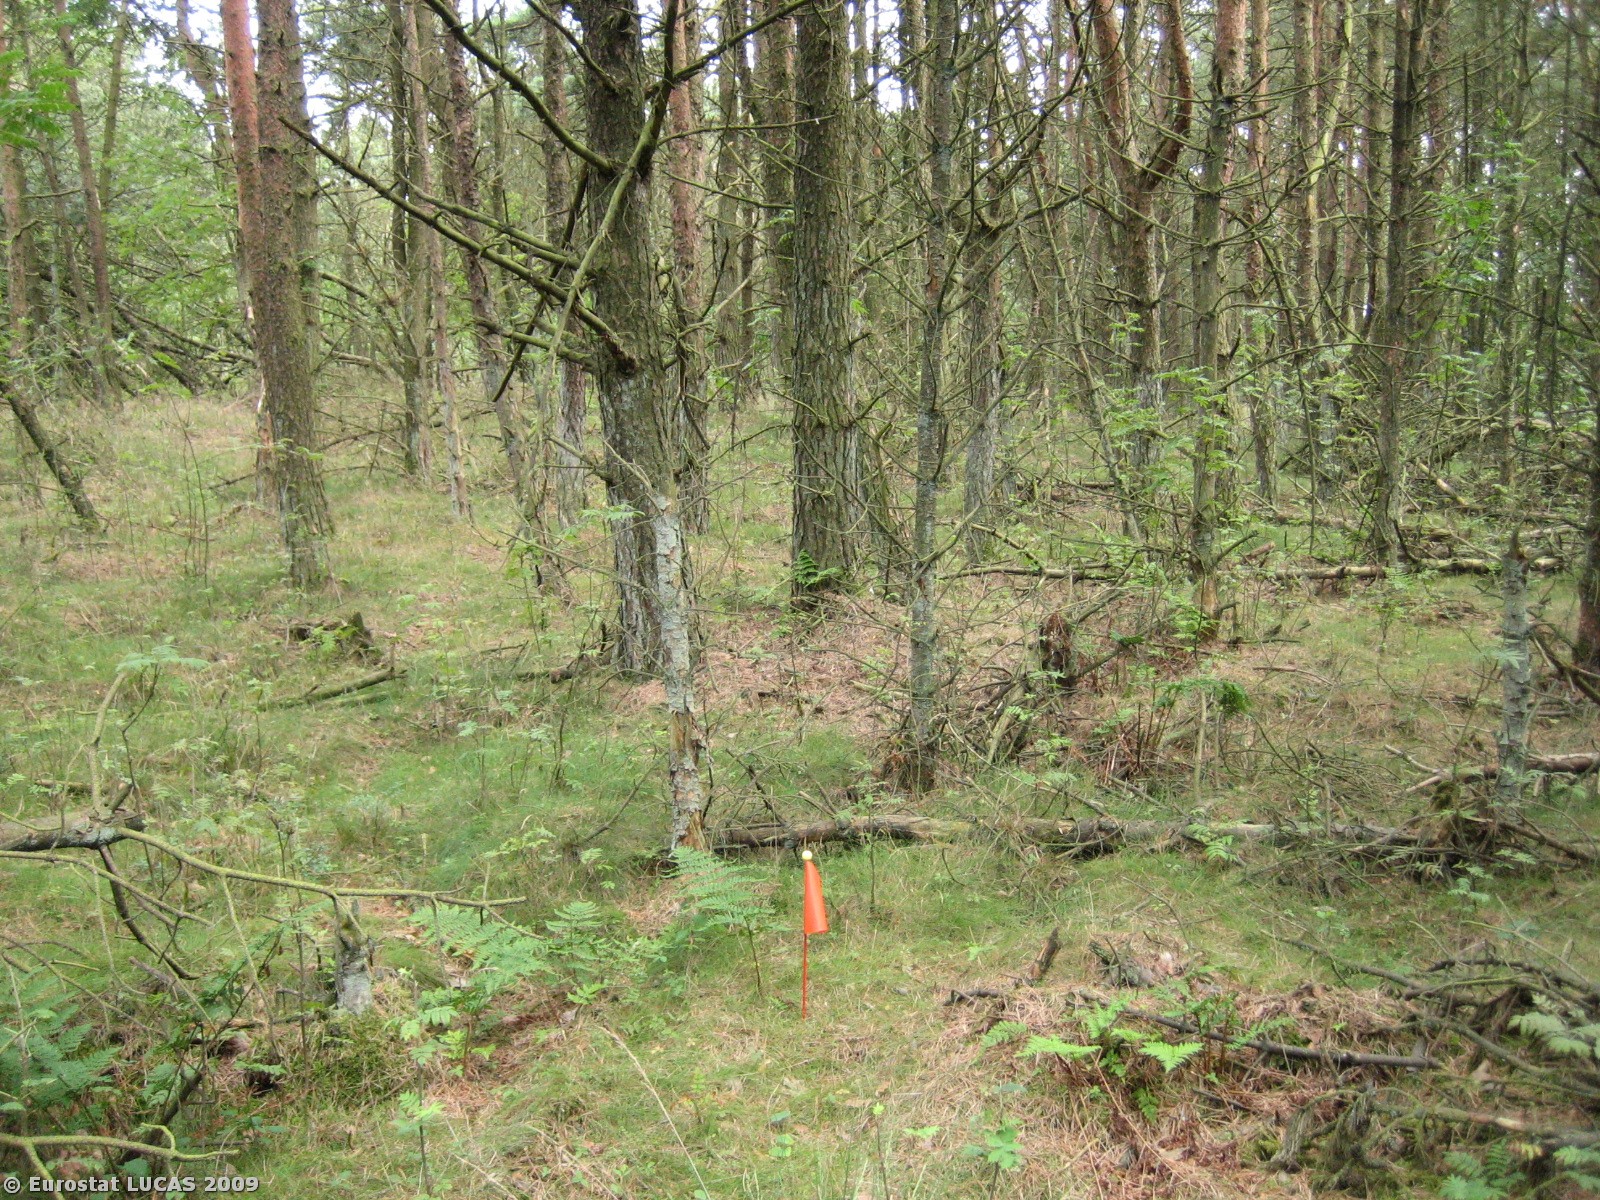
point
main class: Woodland
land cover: Coniferous woodland
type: hemiboreal forest and nemoral coniferous forest and mixed broadleaved-coniferous forest
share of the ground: > 75 %
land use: Forestry
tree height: > 5 m
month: July
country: DK
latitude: 55.7261
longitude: 8.2343
